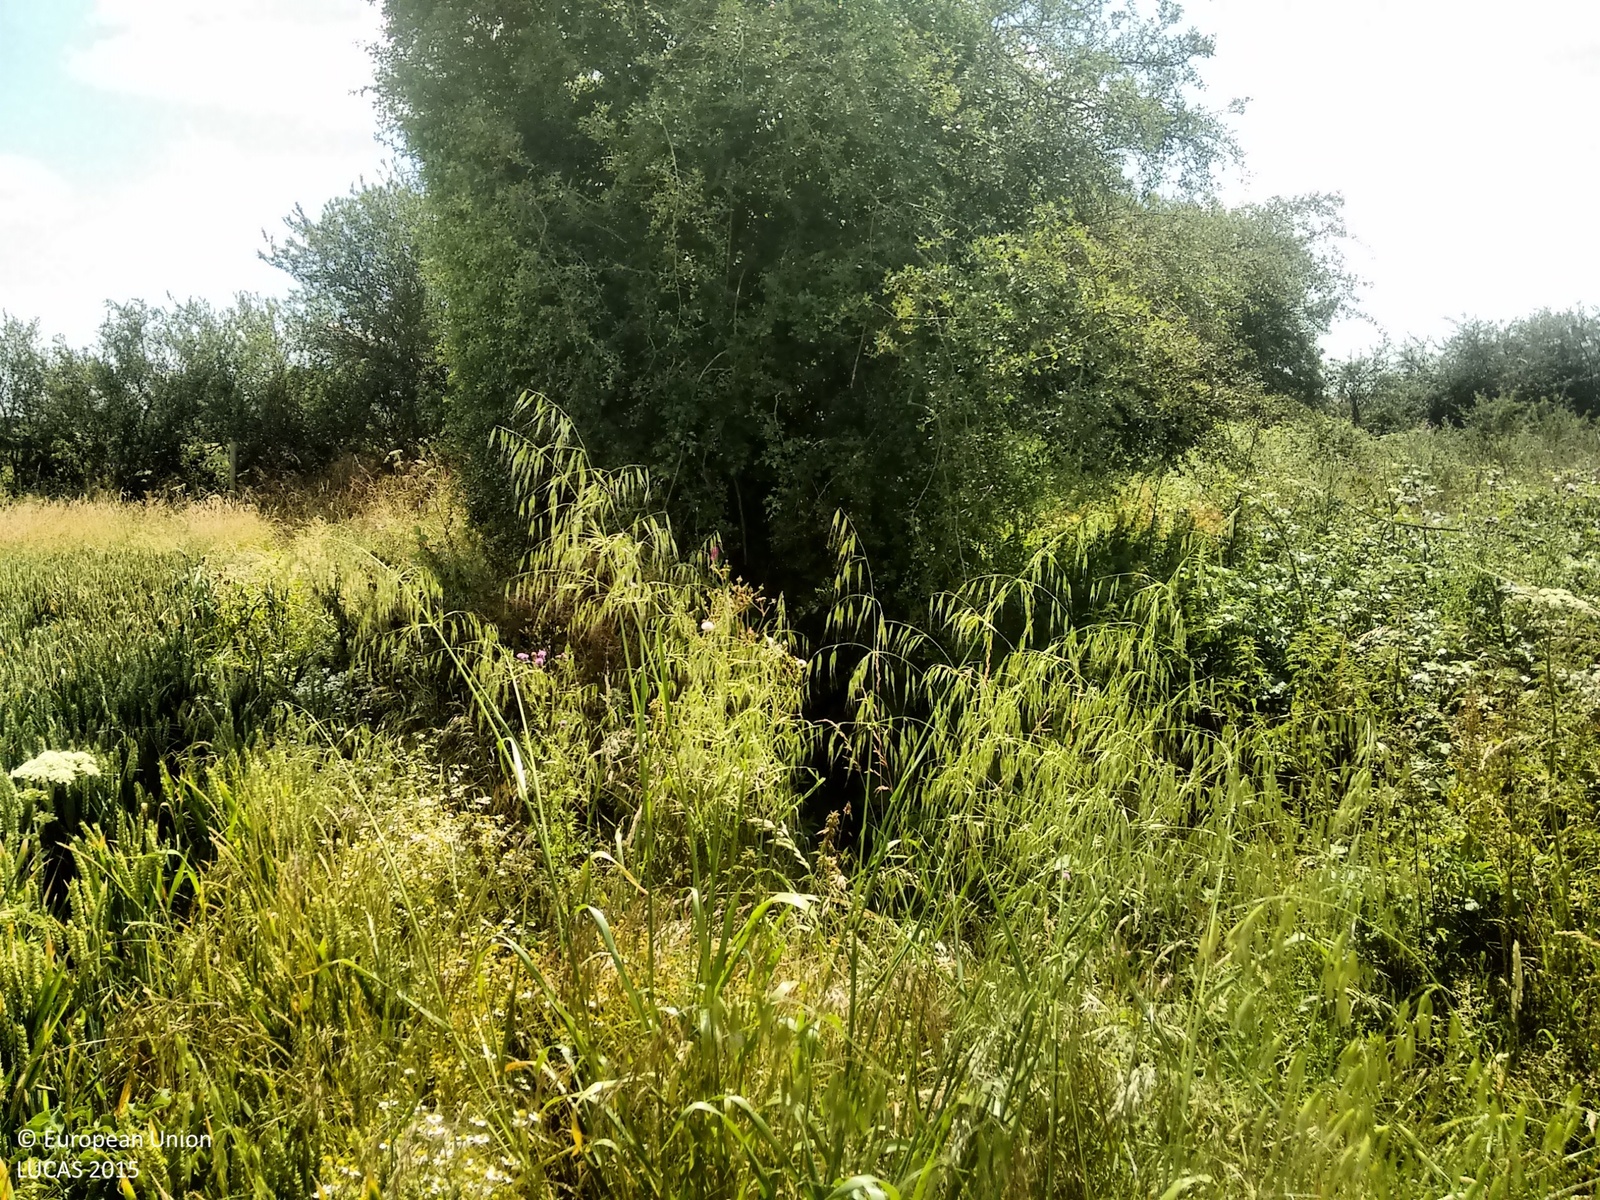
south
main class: Shrubland
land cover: Shrubland with sparse tree cover
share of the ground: > 75 %
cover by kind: shrubs 95 %, broadleaved forest trees 5 %
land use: Semi-natural and natural areas not in use
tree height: < 5 m
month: July
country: GB
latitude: 51.5894
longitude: 0.4016
